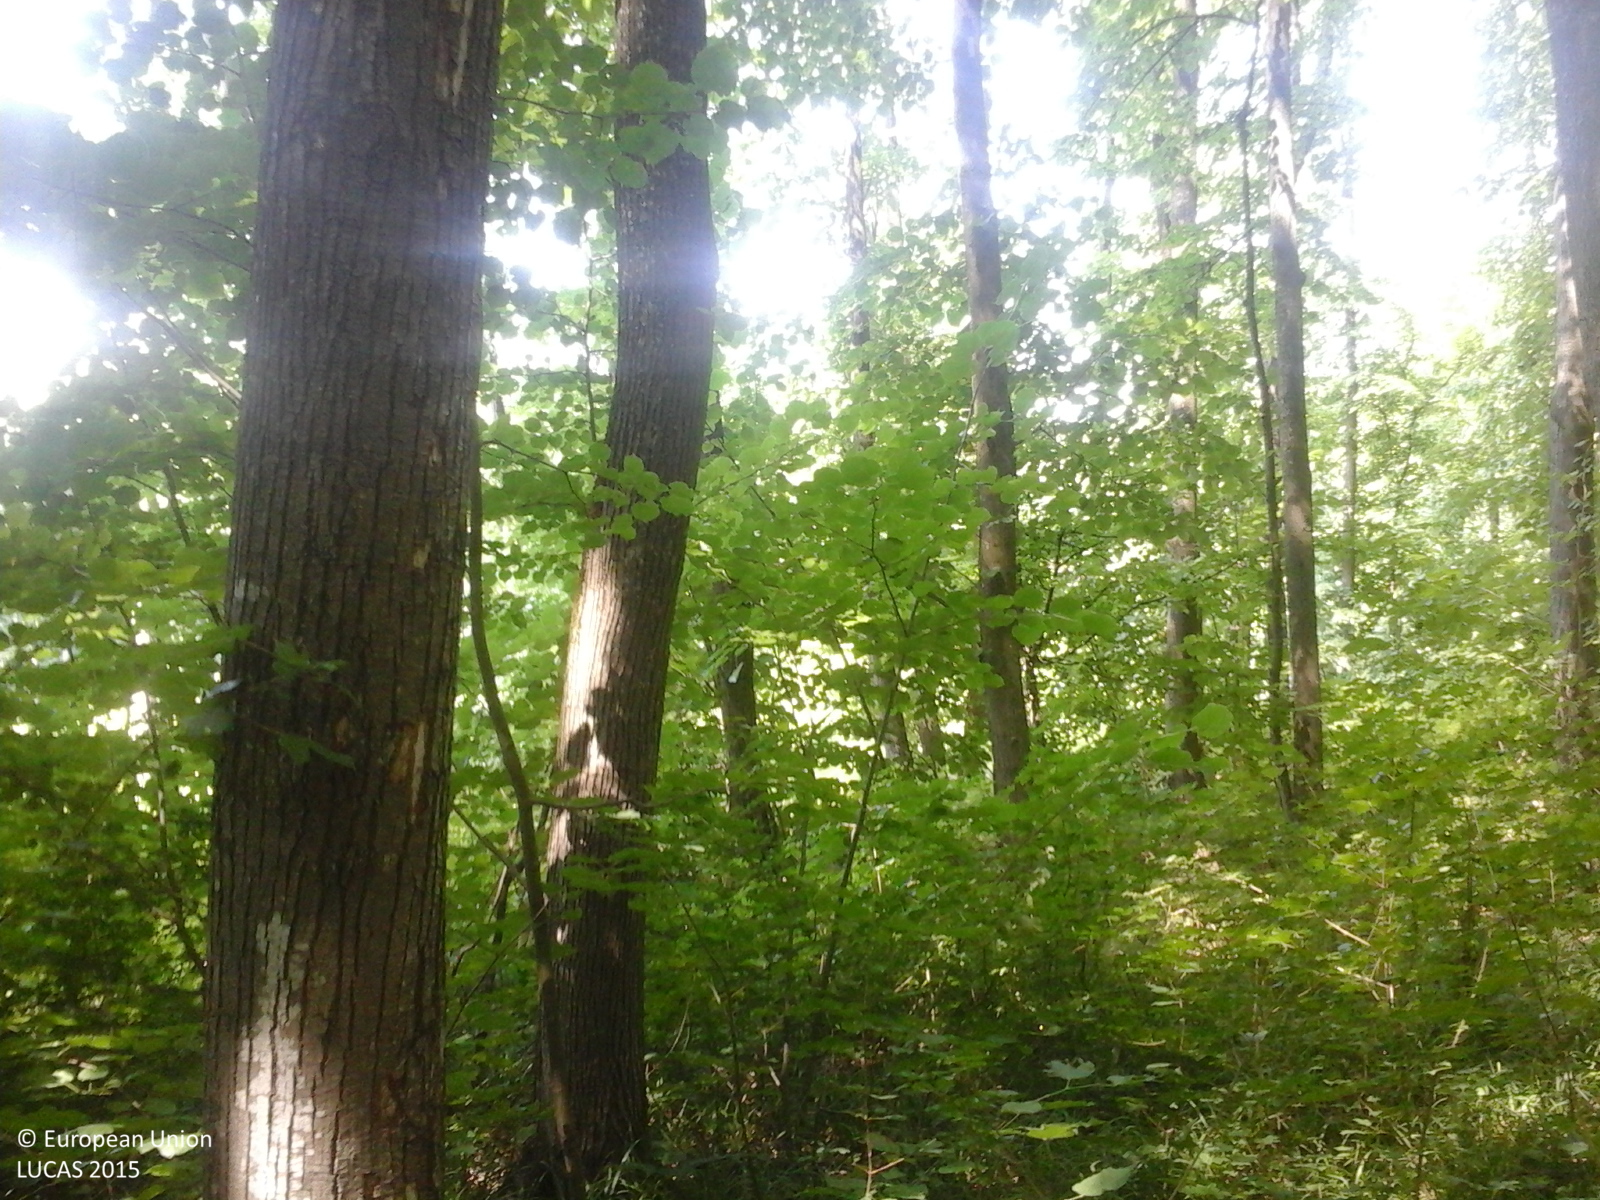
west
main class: Woodland
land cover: Broadleaved woodland
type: beech forest
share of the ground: > 75 %
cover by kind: broadleaved forest trees 95 %, herbaceous plants 5 %
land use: Forestry
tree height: > 5 m
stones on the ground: < 10 %
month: June
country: RO
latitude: 46.9376
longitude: 27.2759
